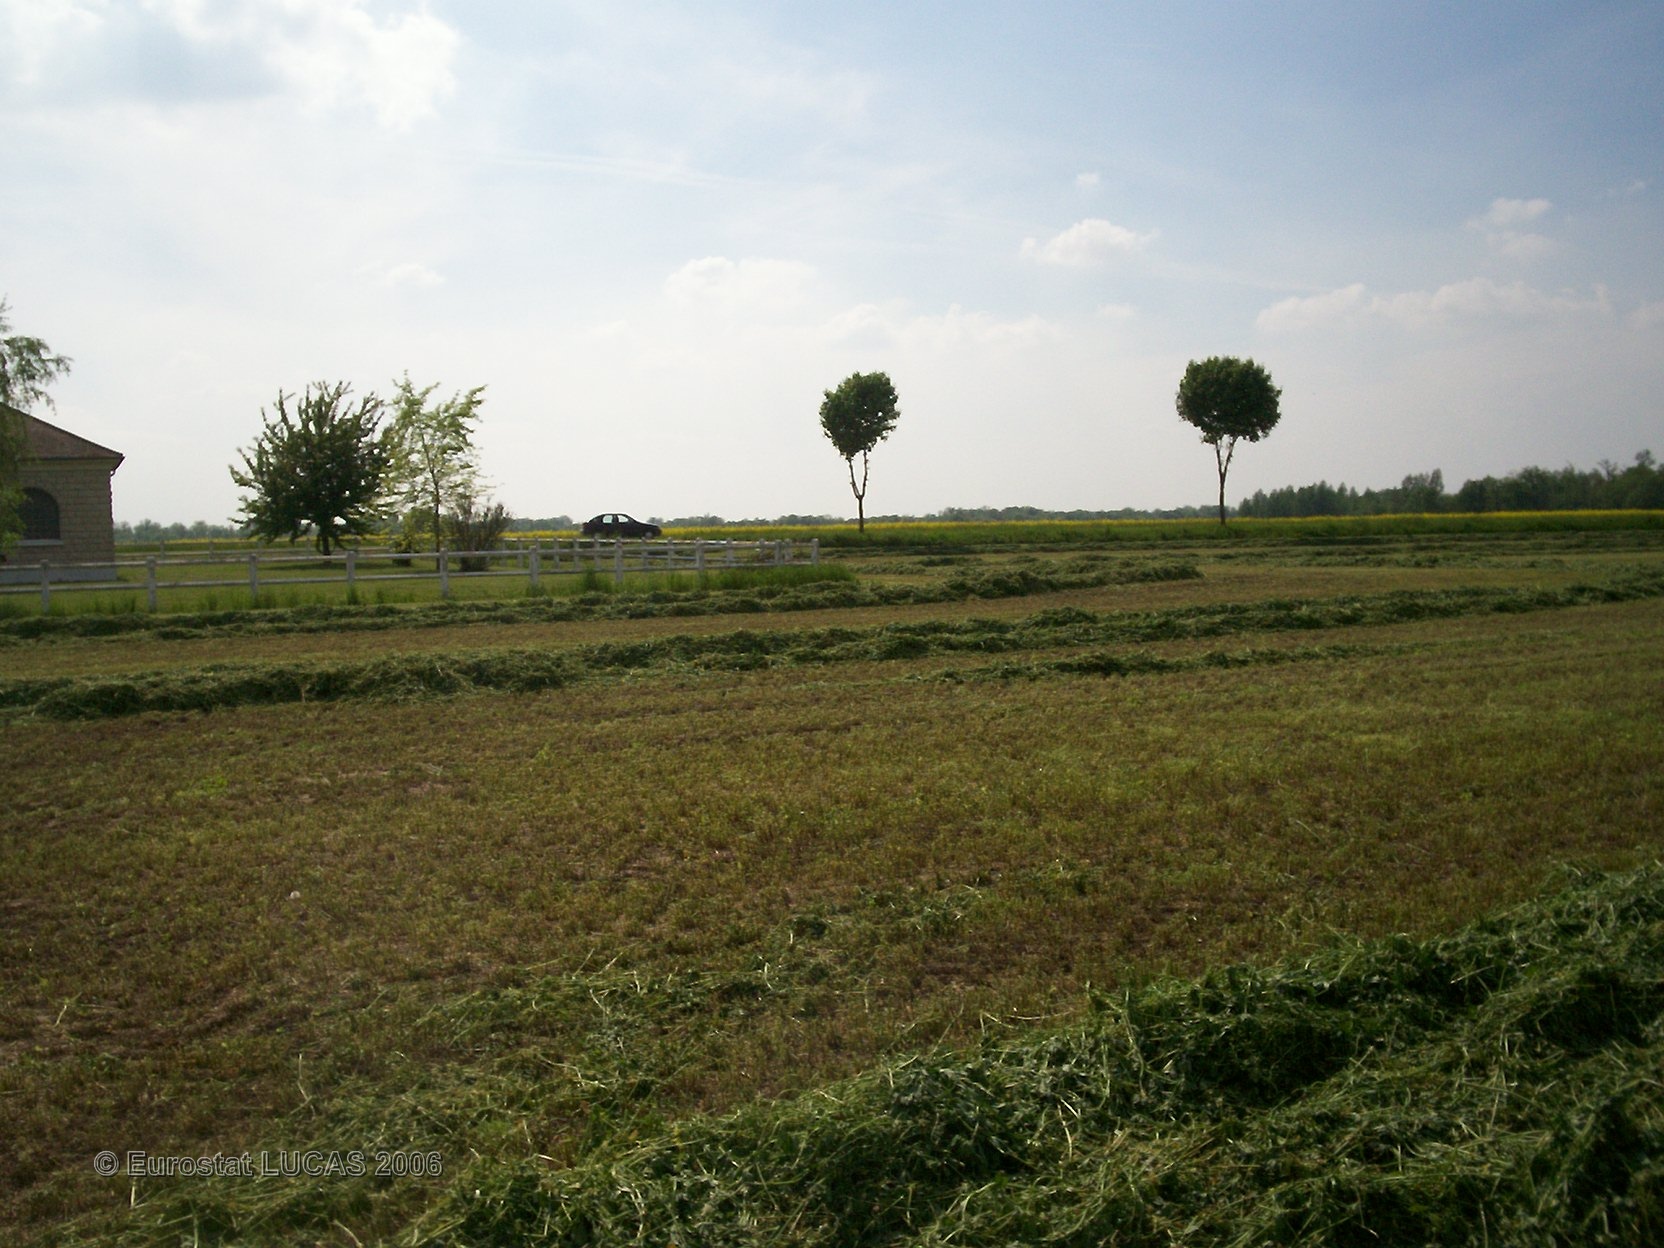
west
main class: Cropland
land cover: Lucerne
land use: Agriculture (excluding fallow land and kitchen gardens)
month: May
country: FR
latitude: 48.8951
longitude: 4.4451
